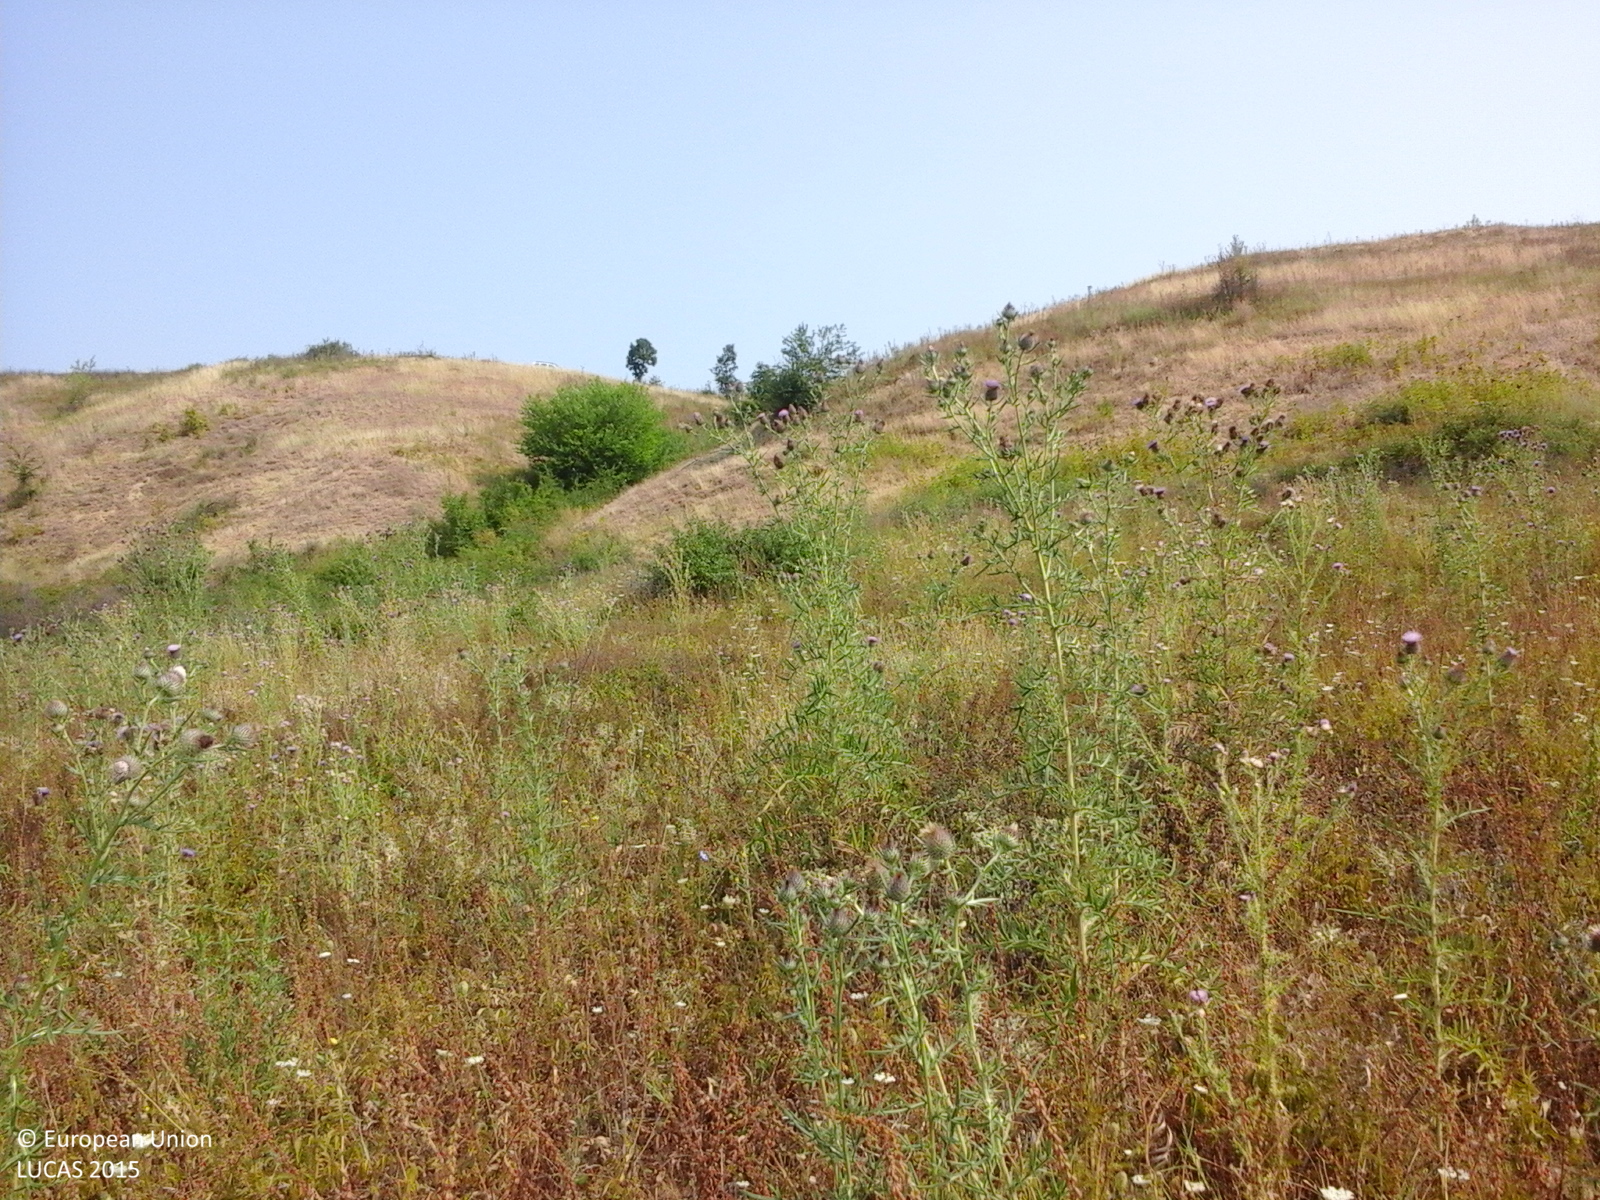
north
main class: Grassland
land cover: Spontaneously vegetated surfaces
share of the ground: > 75 %
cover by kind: herbaceous plants 100 %
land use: Fallow land
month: August
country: RO
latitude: 44.4824
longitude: 23.3916
